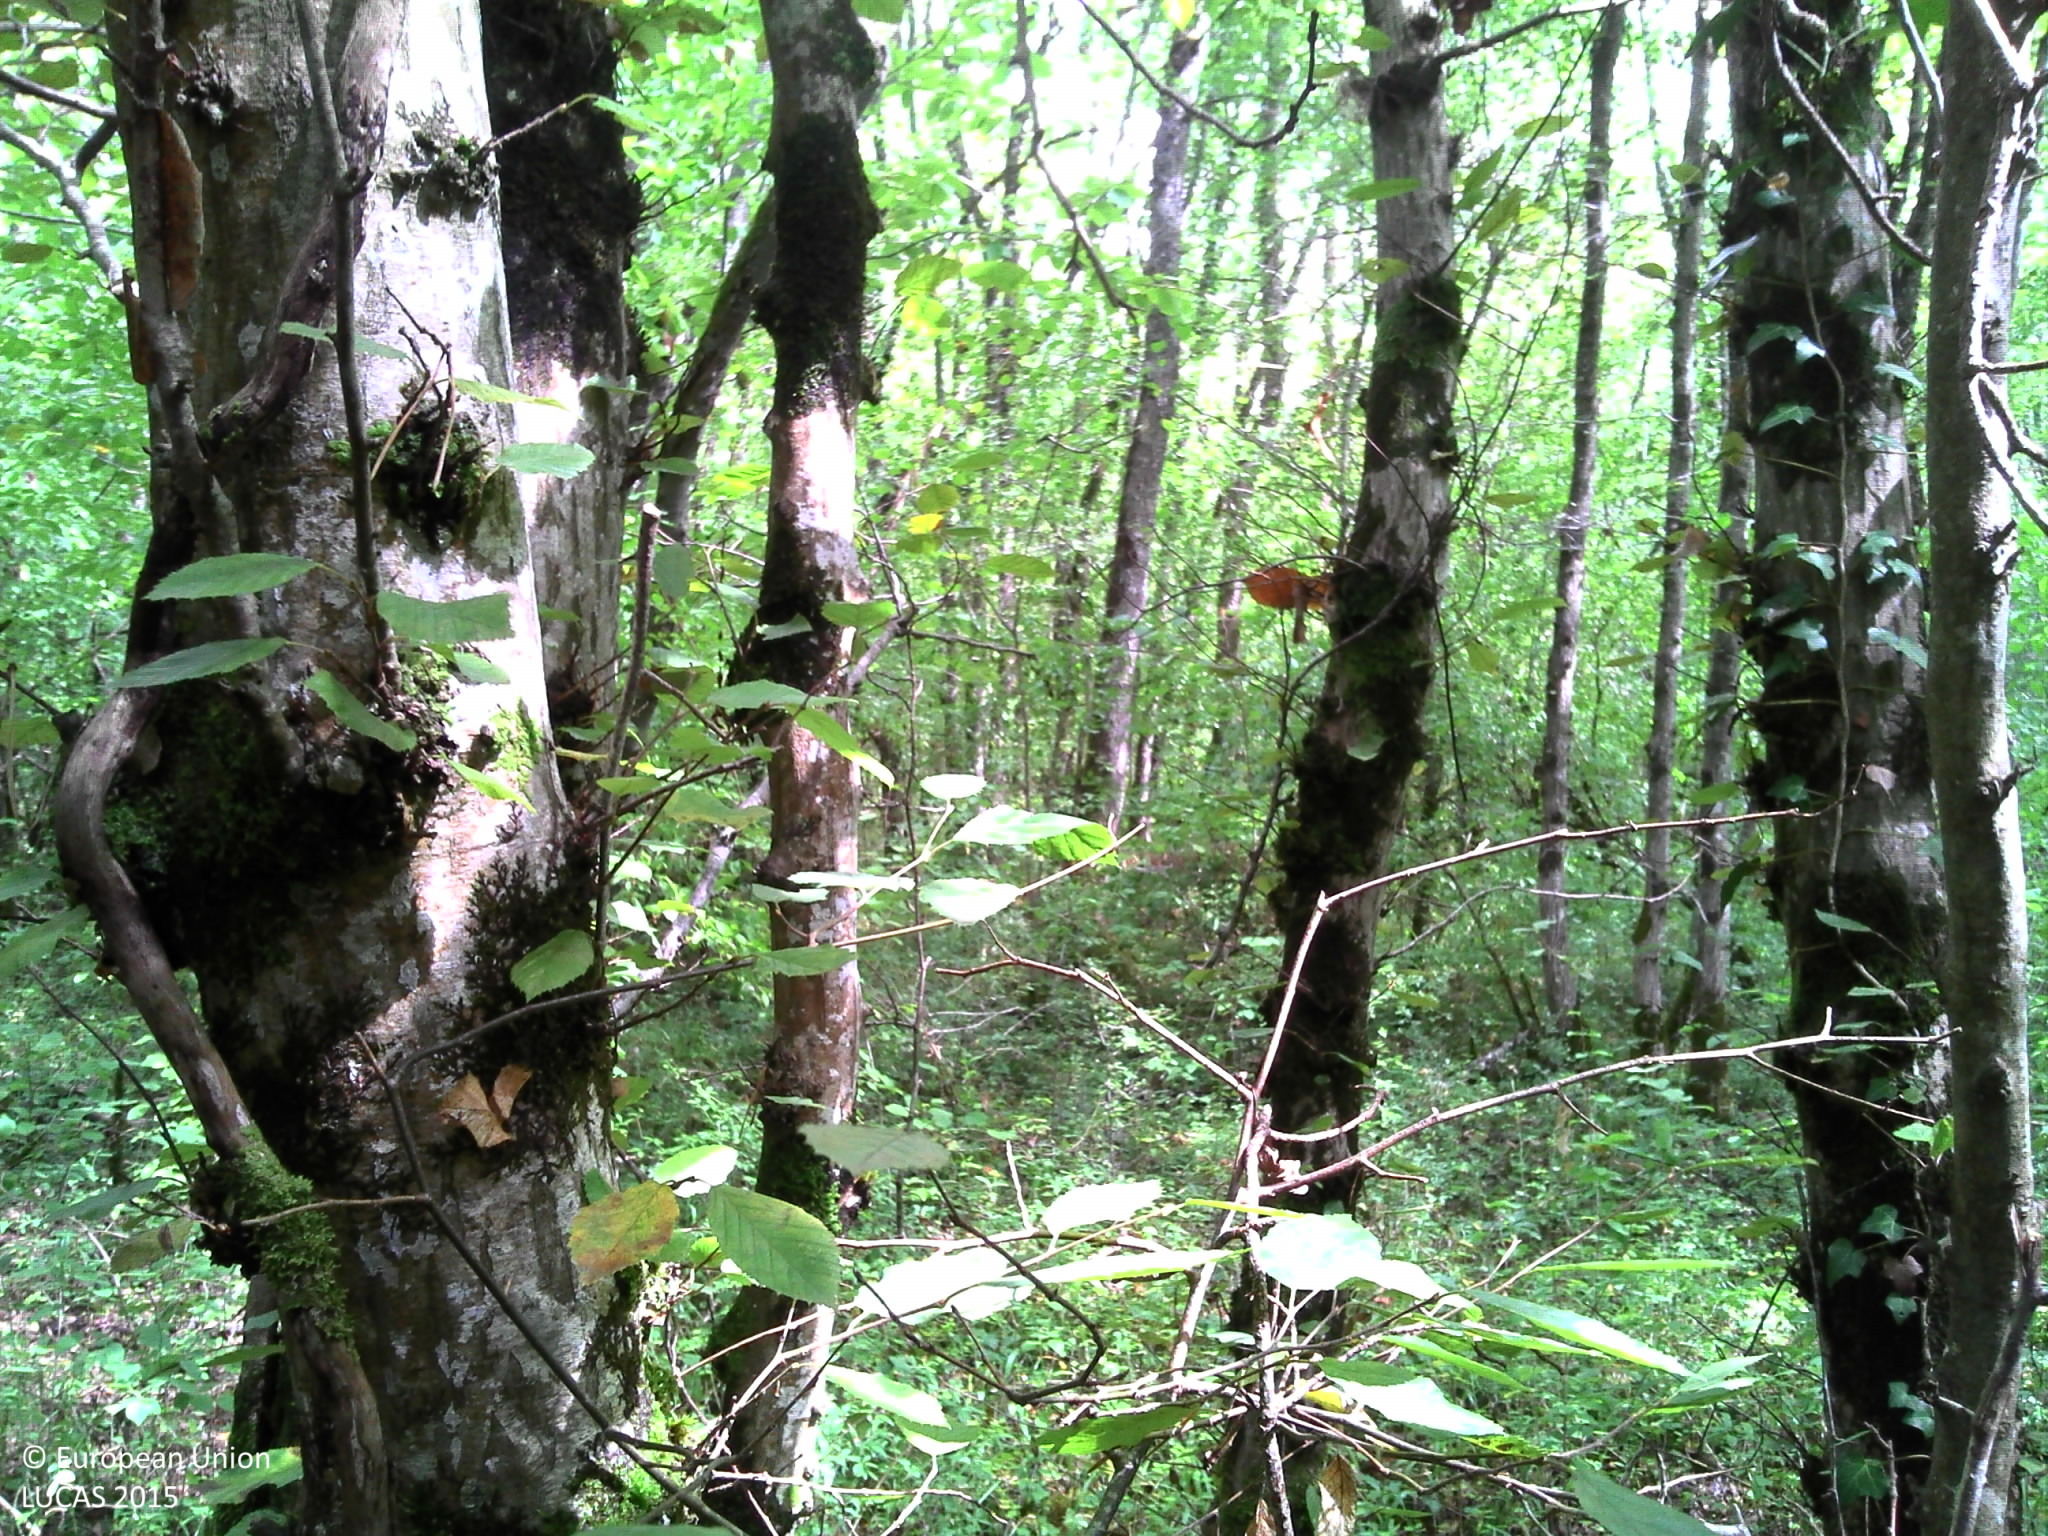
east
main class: Woodland
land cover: Broadleaved woodland
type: mesophytic deciduous forest
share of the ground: > 75 %
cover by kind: broadleaved forest trees 85 %, shrubs 5 %, herbaceous plants 5 %, lichens and mosses 5 %
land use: Forestry
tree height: > 5 m
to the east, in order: Broadleaved woodland
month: August
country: FR
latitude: 47.9407
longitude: 4.8448
